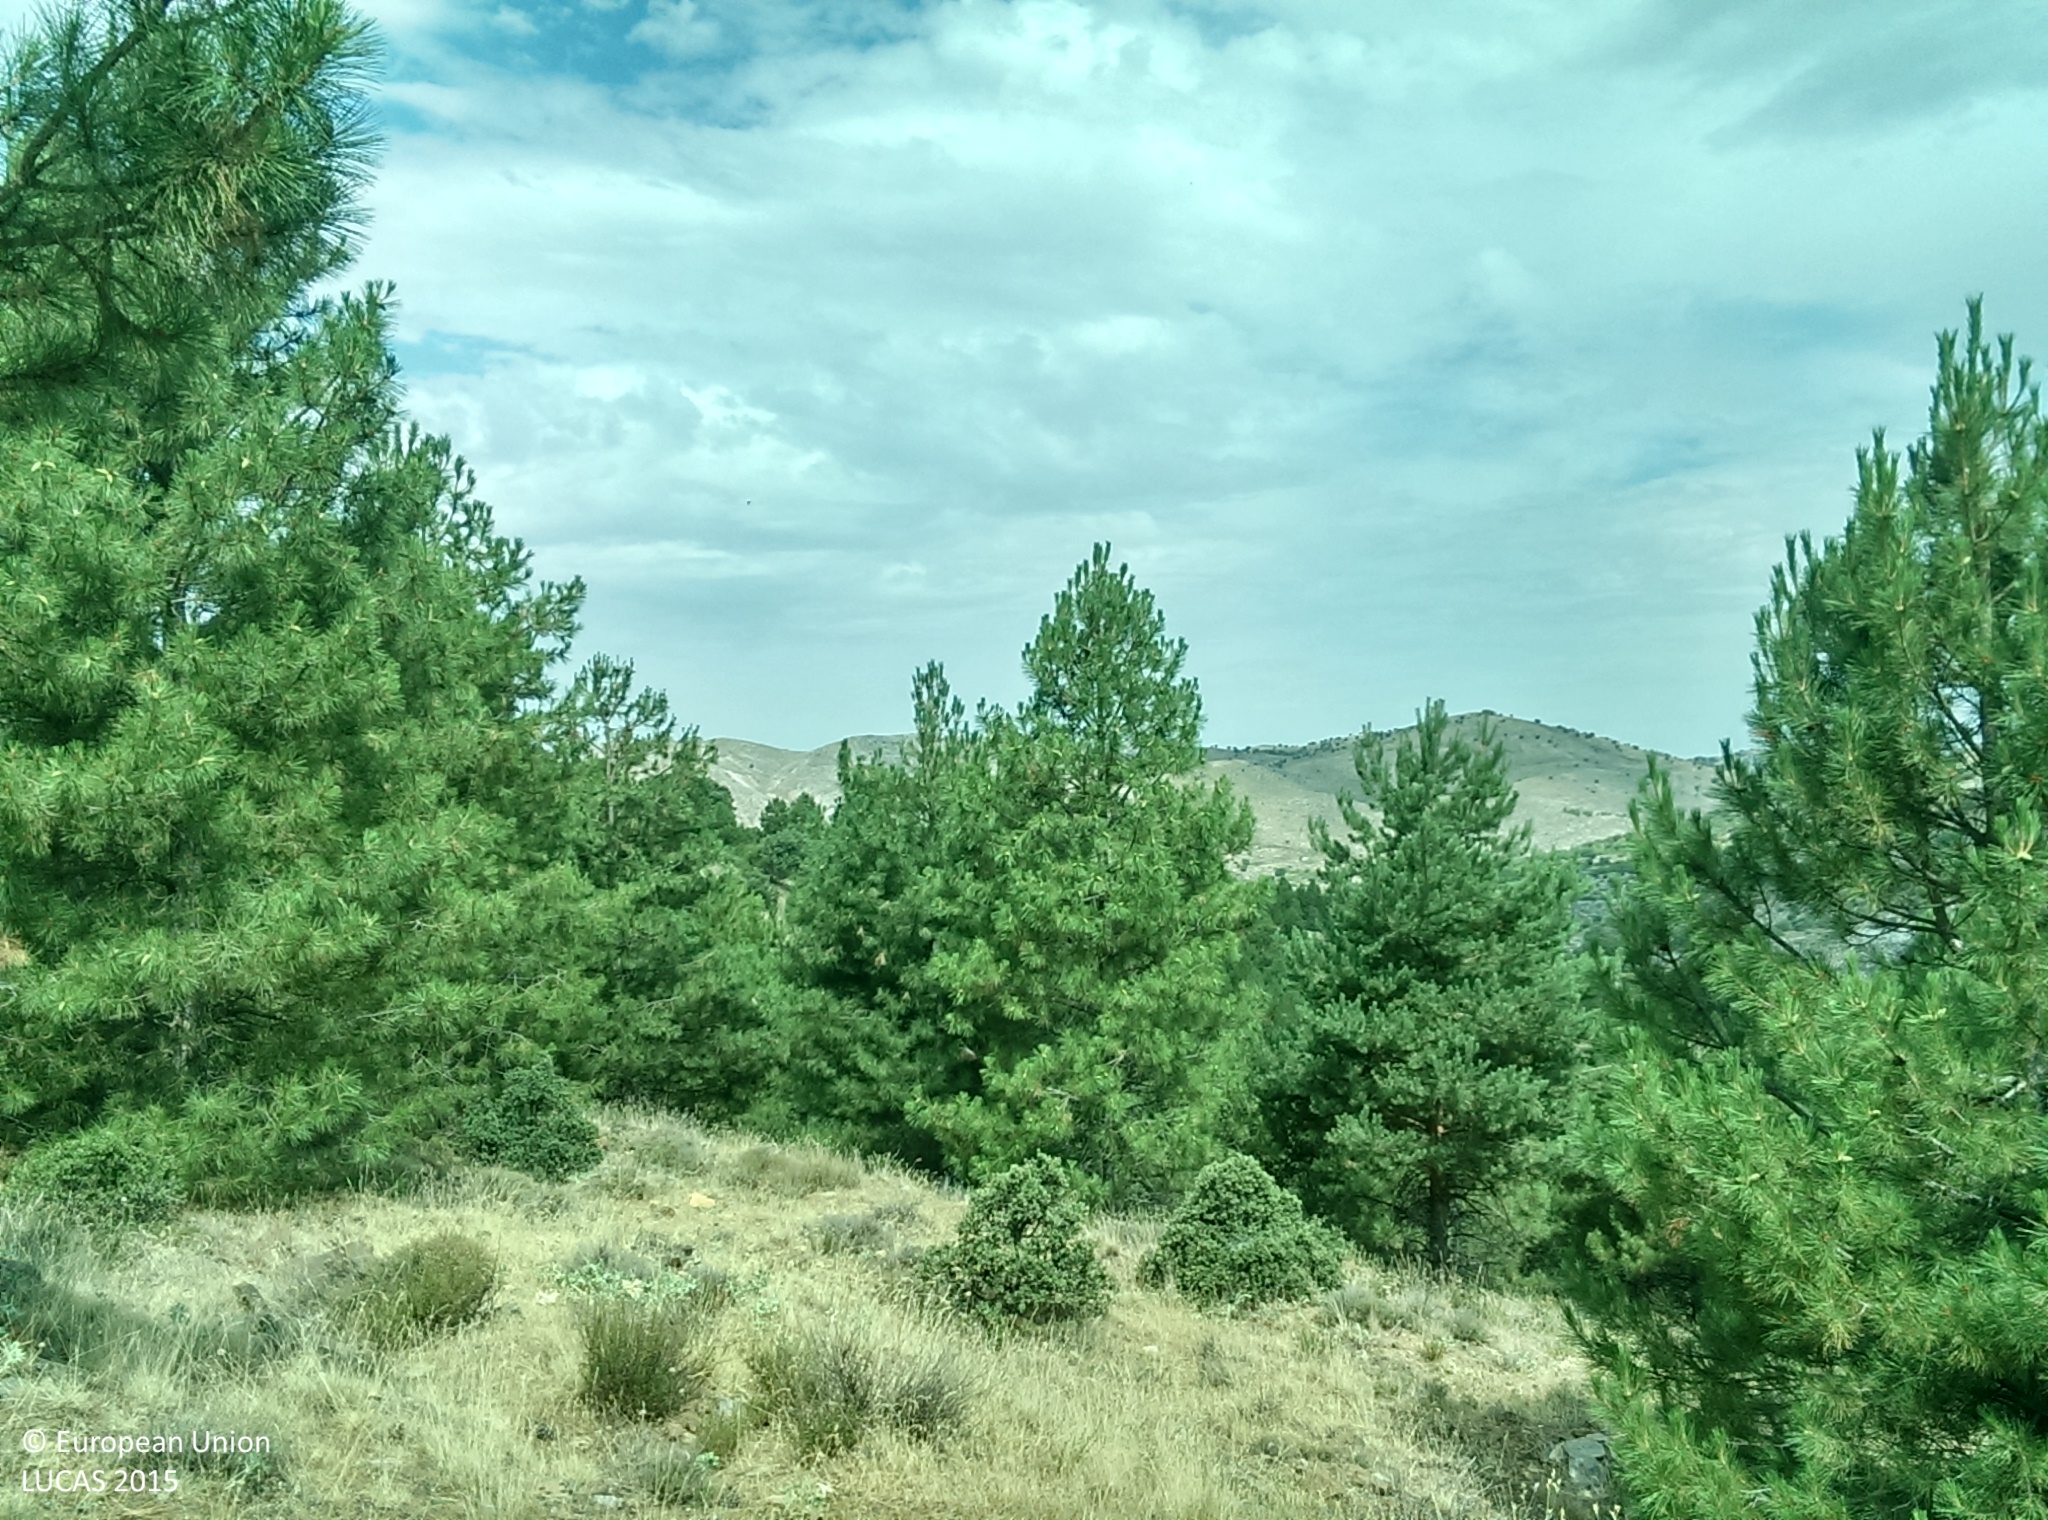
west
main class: Woodland
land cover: Pine dominated coniferous woodland
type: coniferous forest of the mediterranean region
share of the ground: 50 - 75 %
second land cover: Grassland without tree/shrub cover
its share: 25 - 50 %
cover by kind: coniferous forest trees 50 %, herbaceous plants 30 %, shrubs 10 %, unconsolidated bare surface 10 %
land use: Forestry
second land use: Agriculture (excluding fallow land and kitchen gardens)
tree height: > 5 m
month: July
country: ES
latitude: 37.3016
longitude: -2.9255
